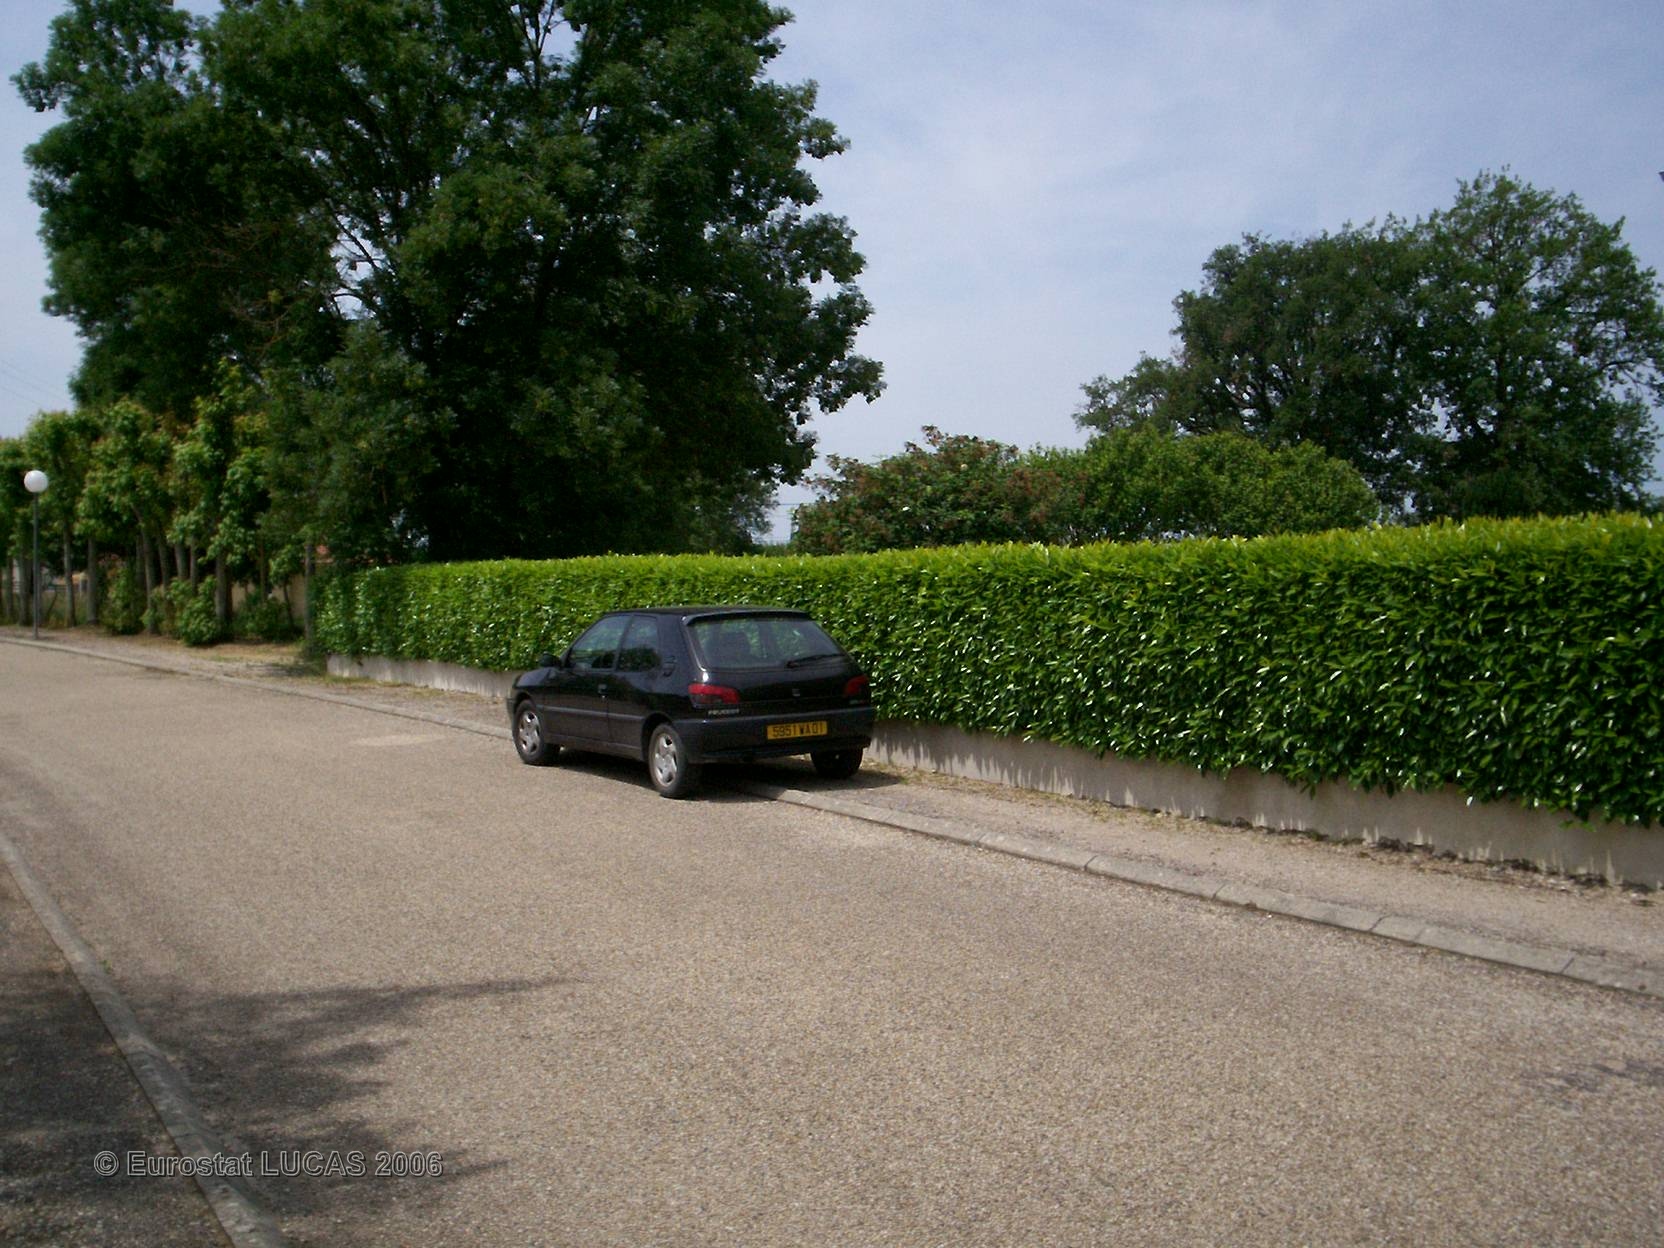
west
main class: Grassland
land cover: Grassland with sparse tree/shrub cover
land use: Residential
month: June
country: FR
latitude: 46.2129
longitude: 5.3237
